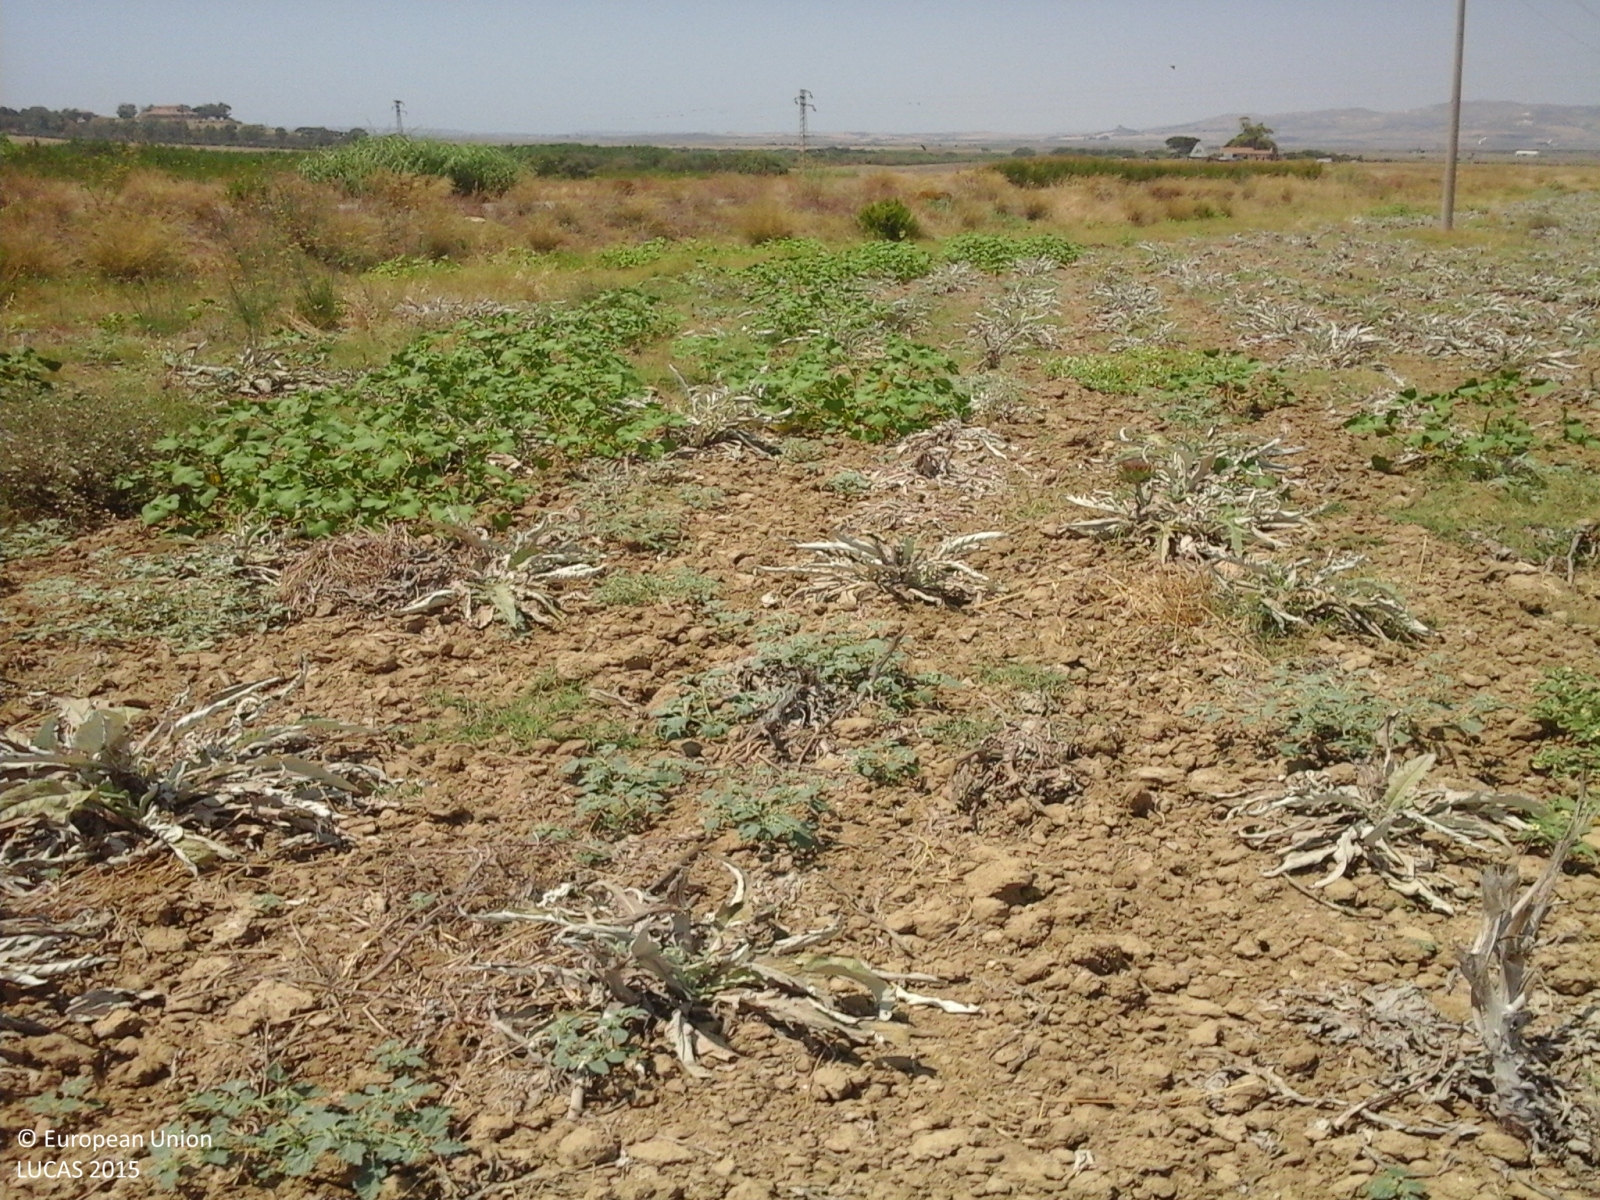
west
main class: Cropland
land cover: Other fresh vegetables
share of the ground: > 75 %
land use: Agriculture (excluding fallow land and kitchen gardens)
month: July
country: IT
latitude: 37.1200
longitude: 14.3665
